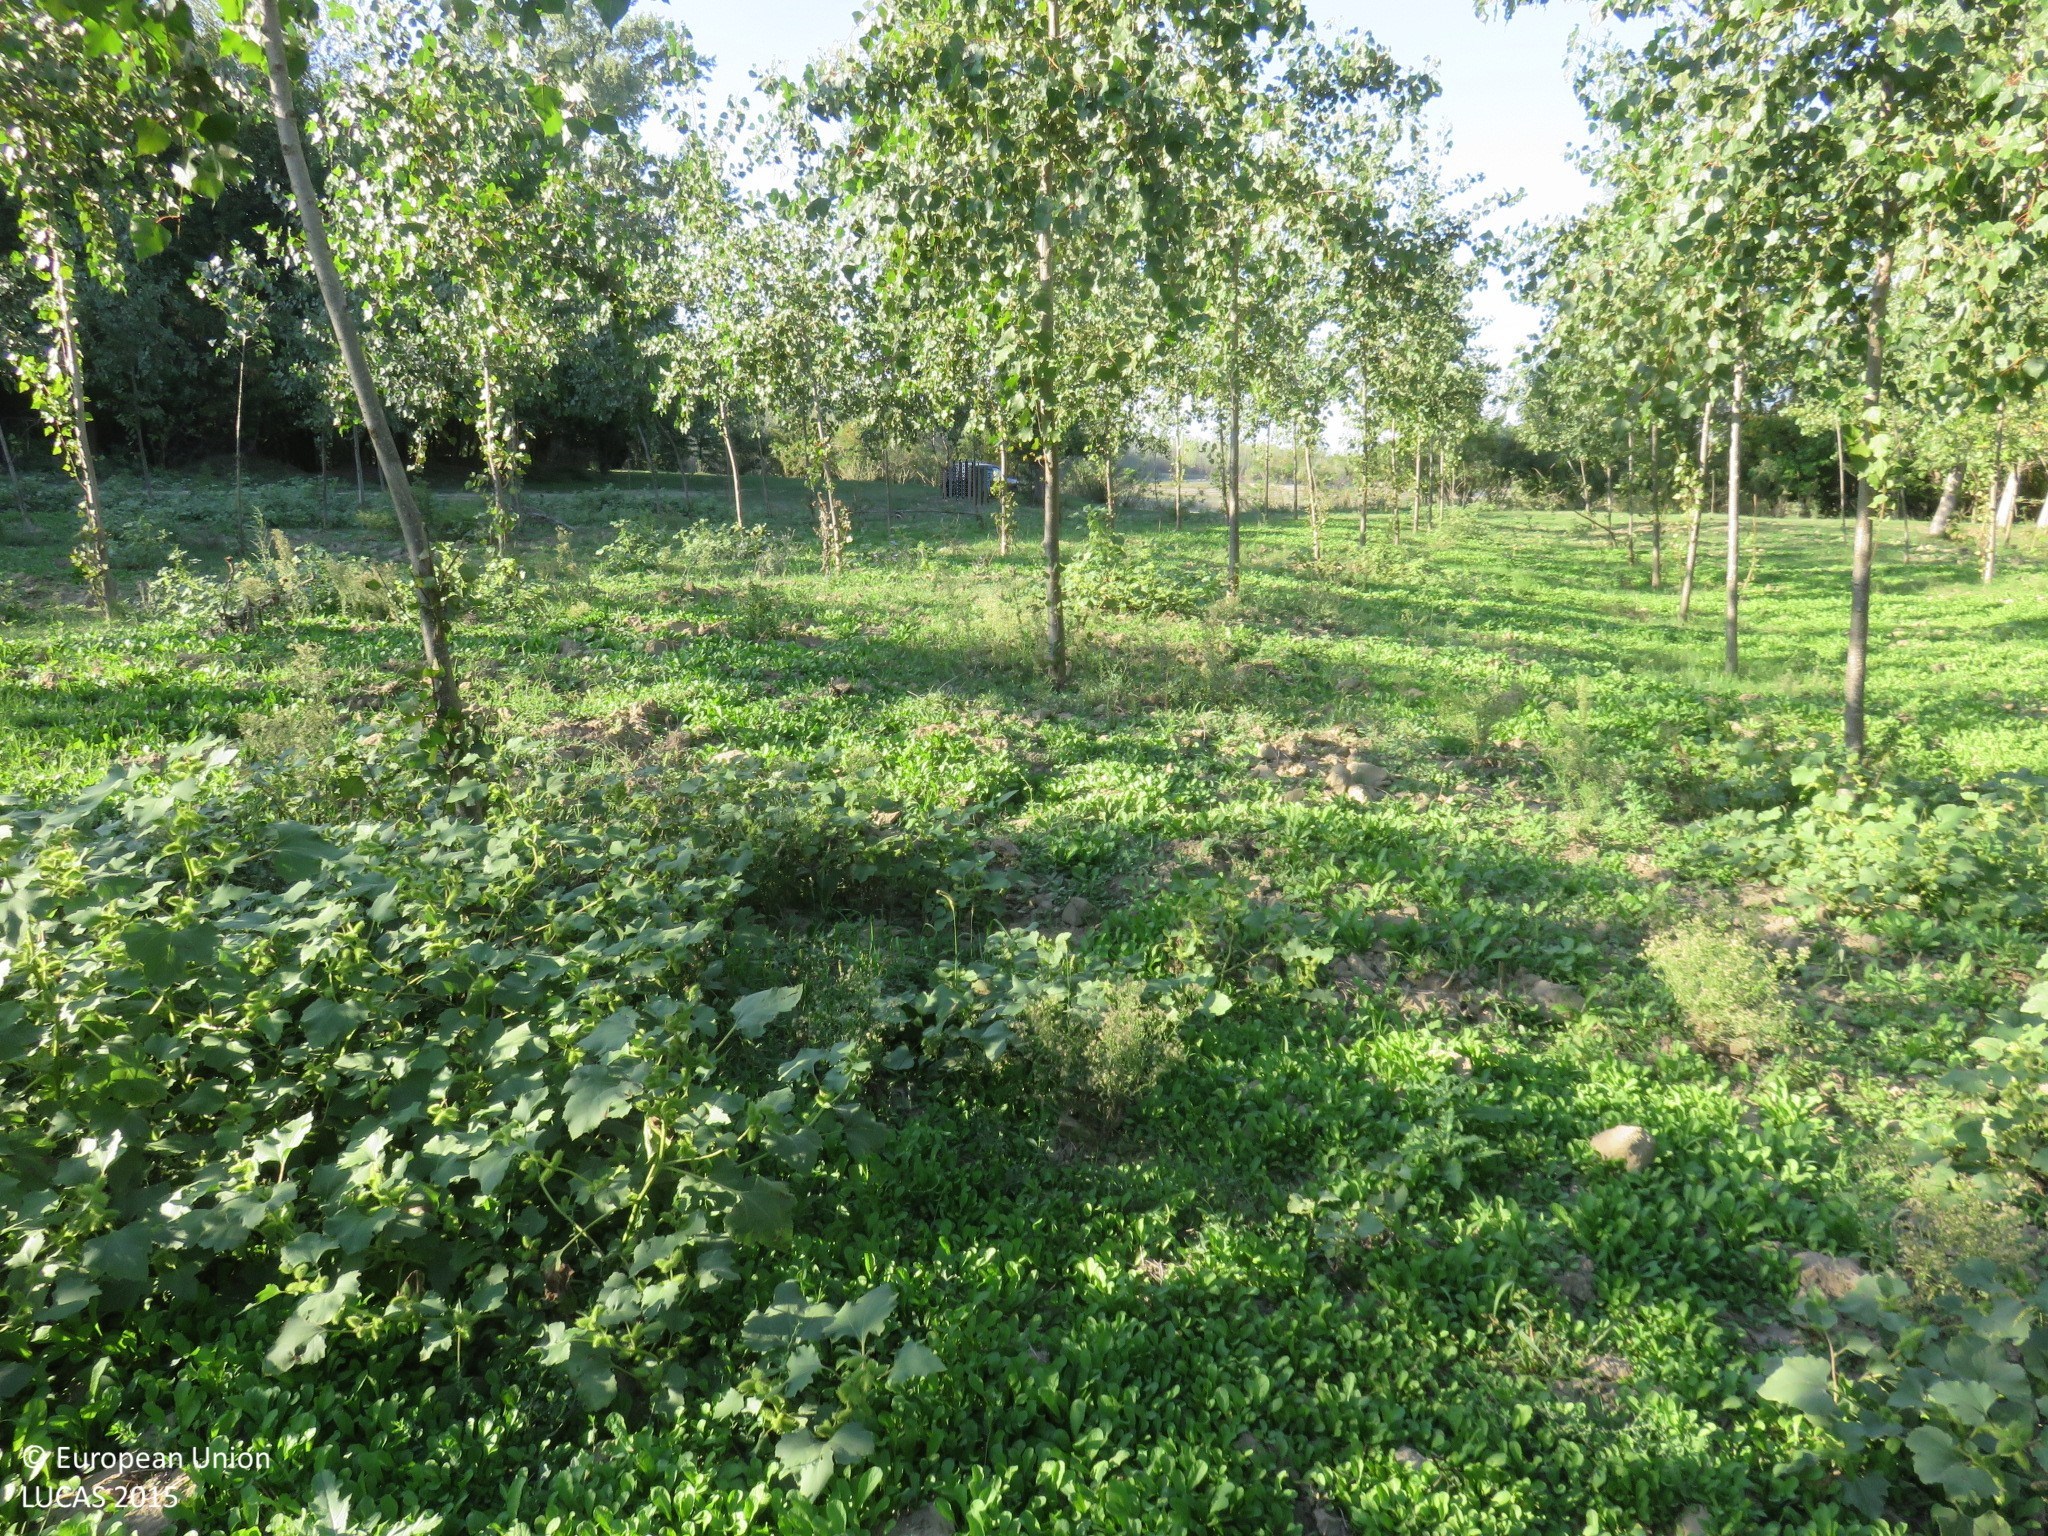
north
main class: Woodland
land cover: Broadleaved woodland
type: floodplain forest
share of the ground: 50 - 75 %
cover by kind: broadleaved forest trees 60 %, herbaceous plants 40 %
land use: Forestry
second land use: Protection infrastructures
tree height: < 5 m
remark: Nursery
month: September
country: BG
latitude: 43.7140
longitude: 24.9791
